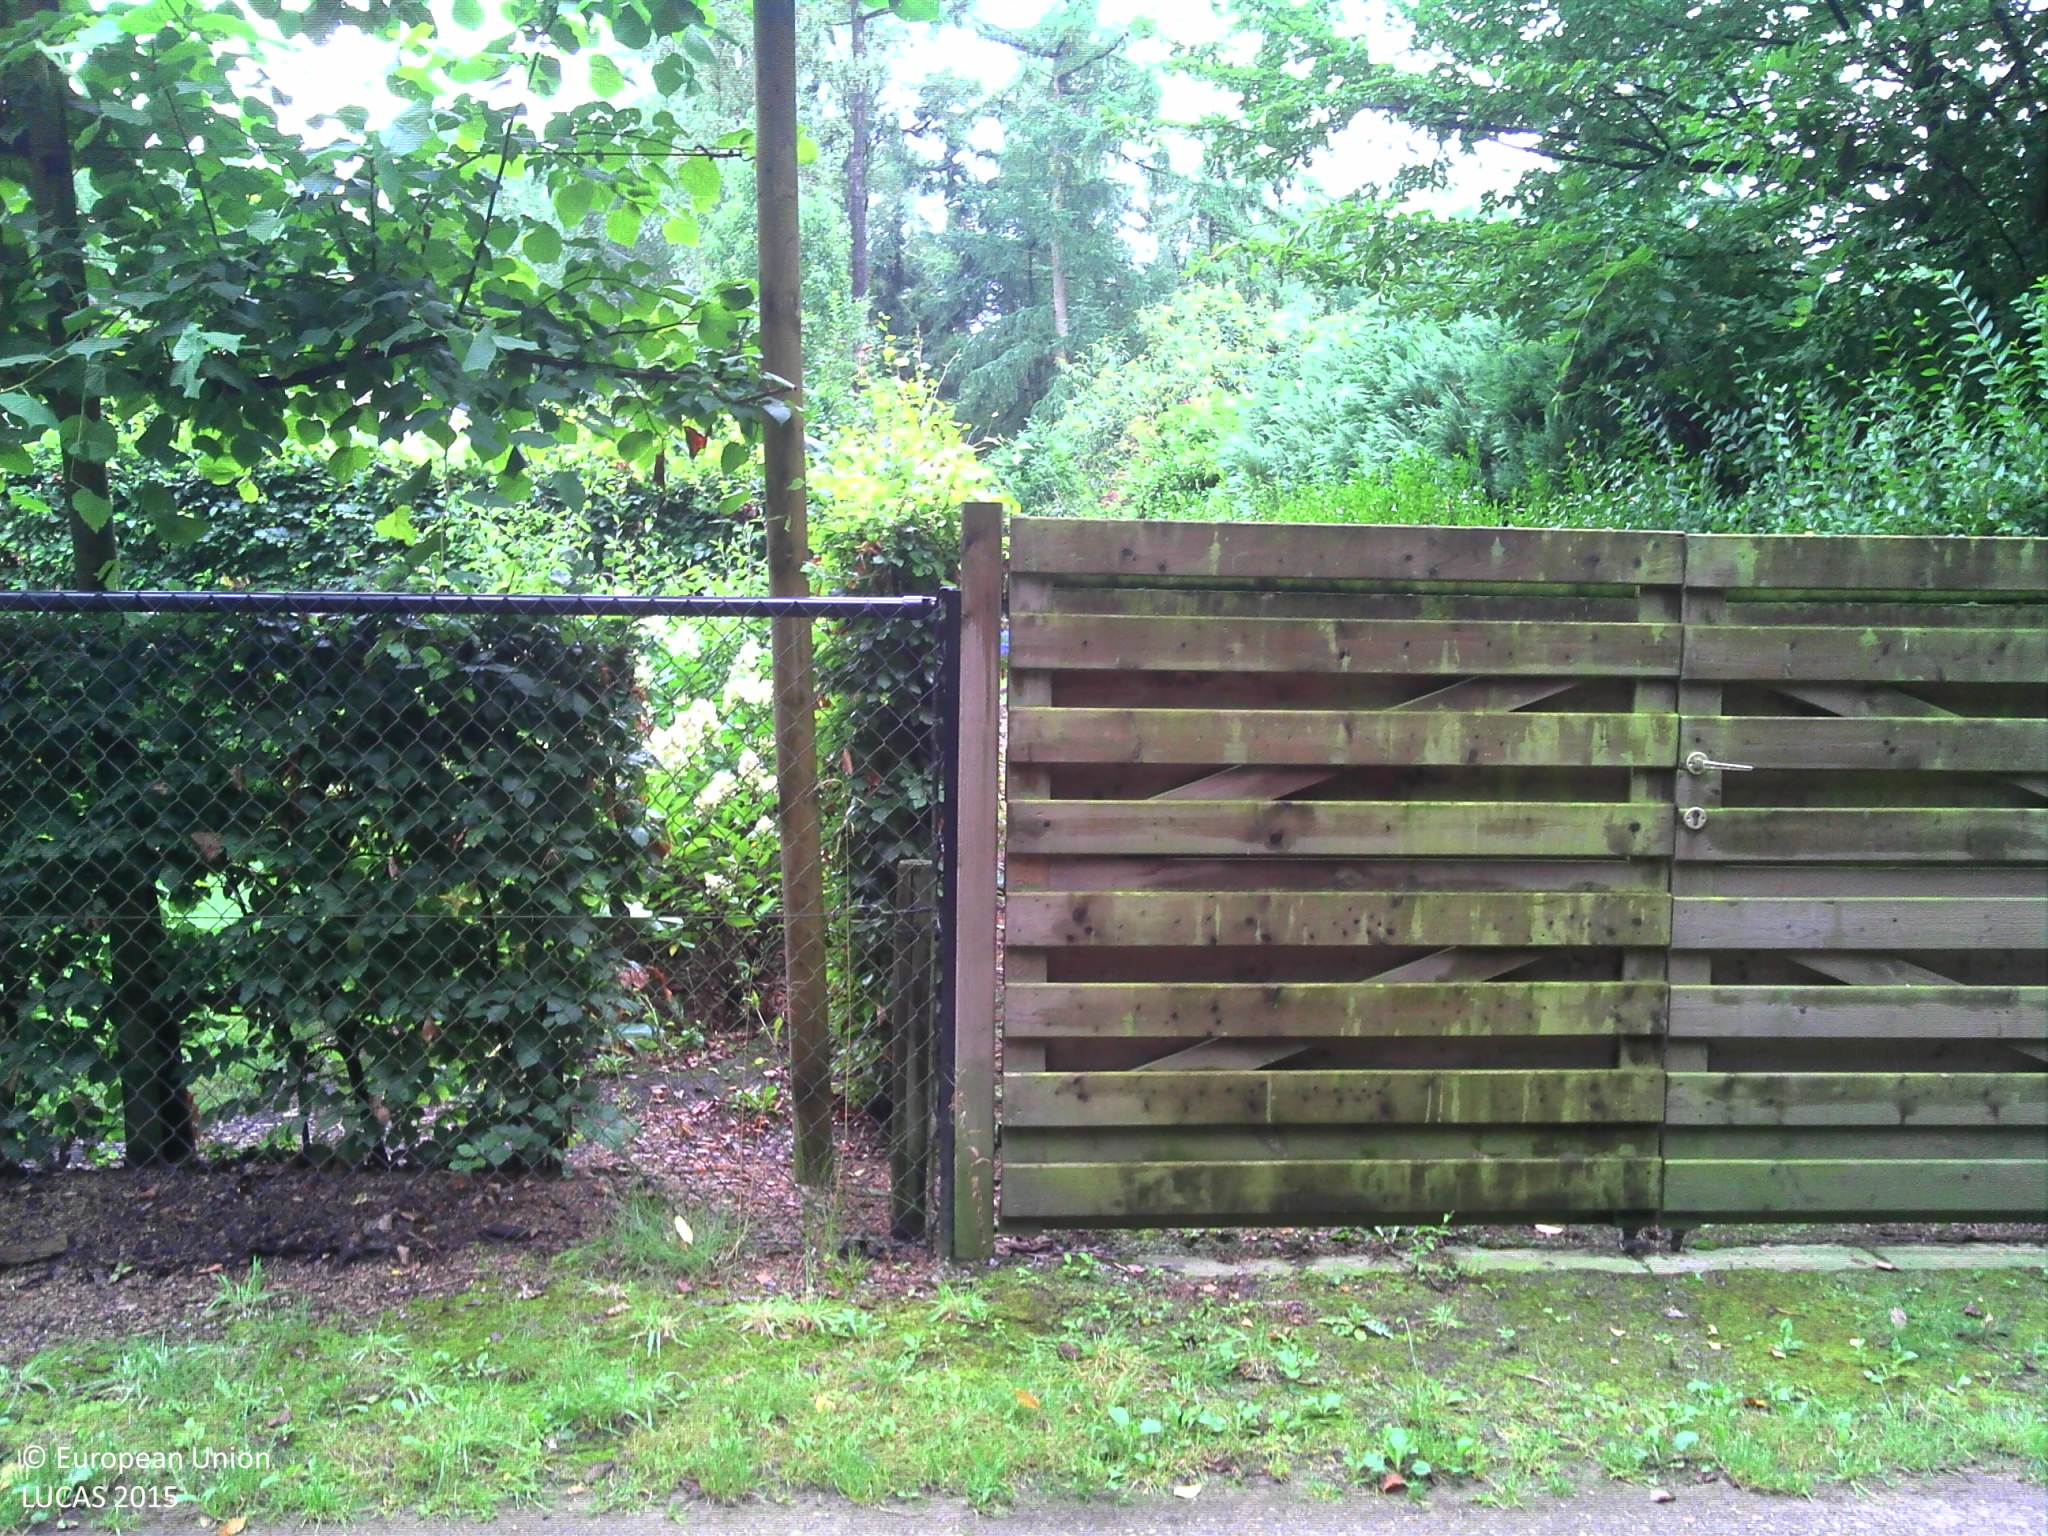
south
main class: Woodland
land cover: Pine dominated coniferous woodland
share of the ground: > 75 %
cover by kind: coniferous forest trees 90 %, broadleaved forest trees 10 %
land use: Residential
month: August
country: BE
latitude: 51.3232
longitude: 5.1328
